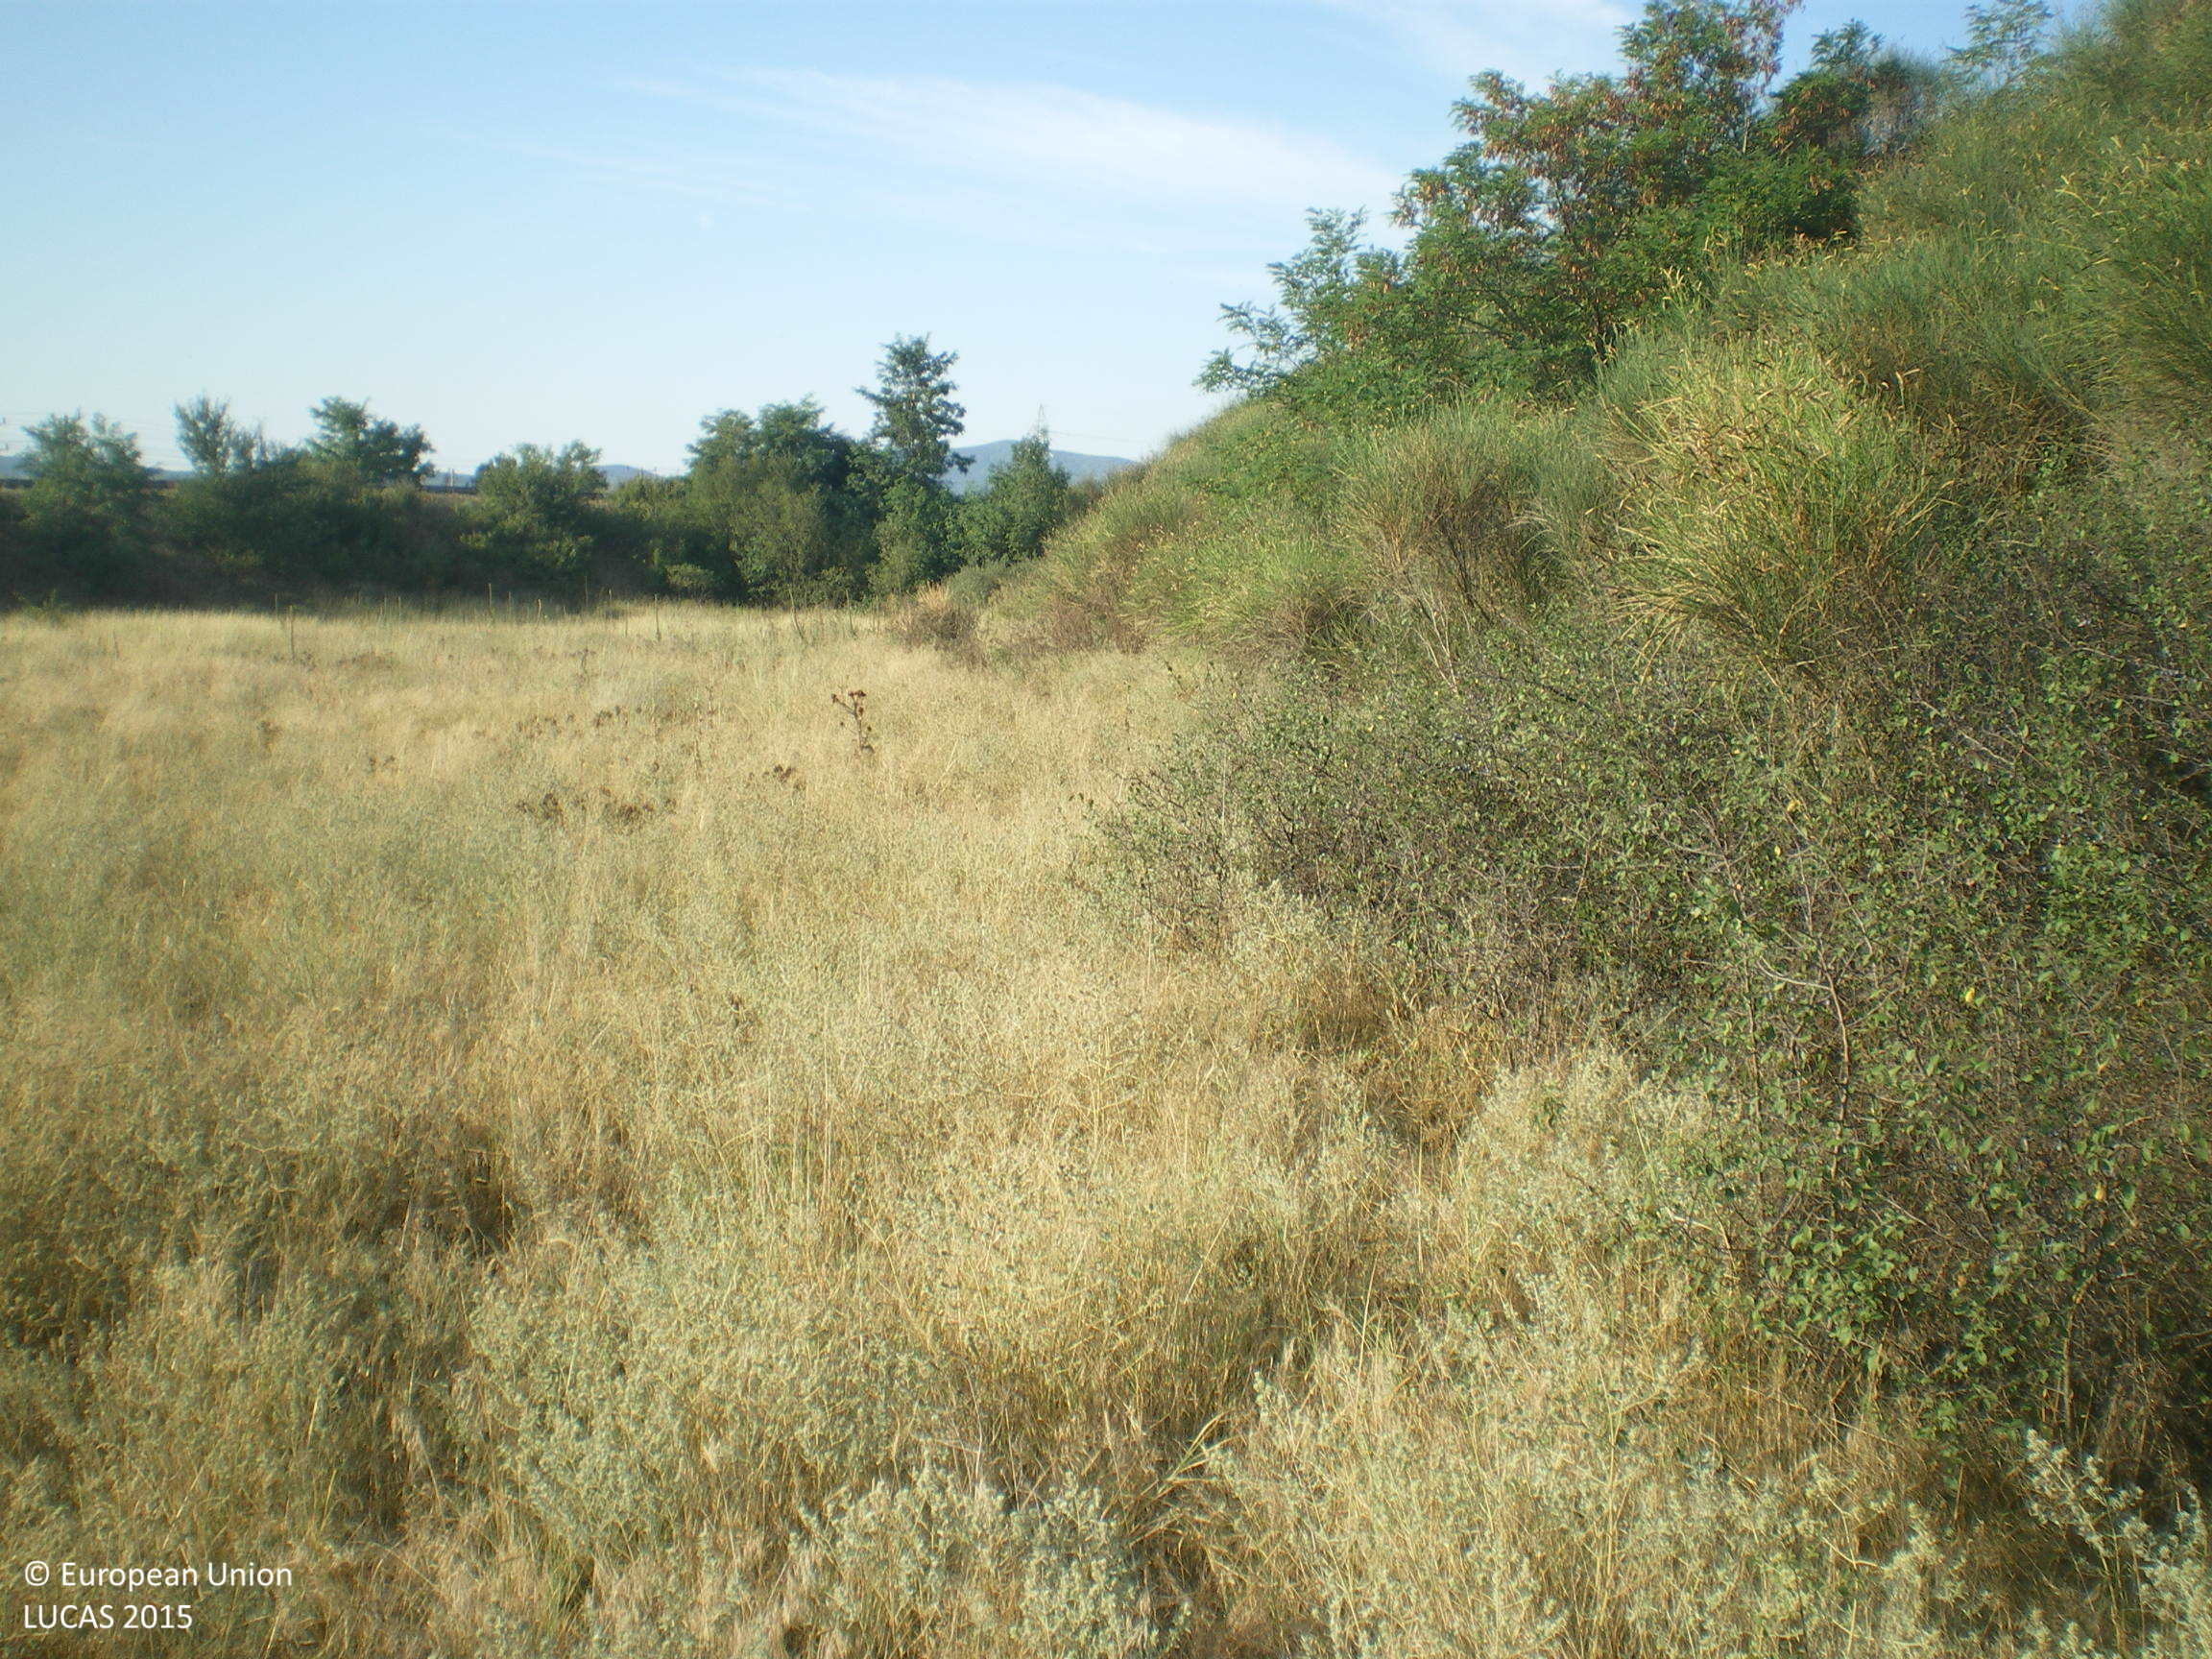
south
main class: Grassland
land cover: Grassland without tree/shrub cover
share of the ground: > 75 %
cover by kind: herbaceous plants 95 %, shrubs 5 %
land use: Road transport
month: August
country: BG
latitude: 42.6053
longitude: 25.6397
